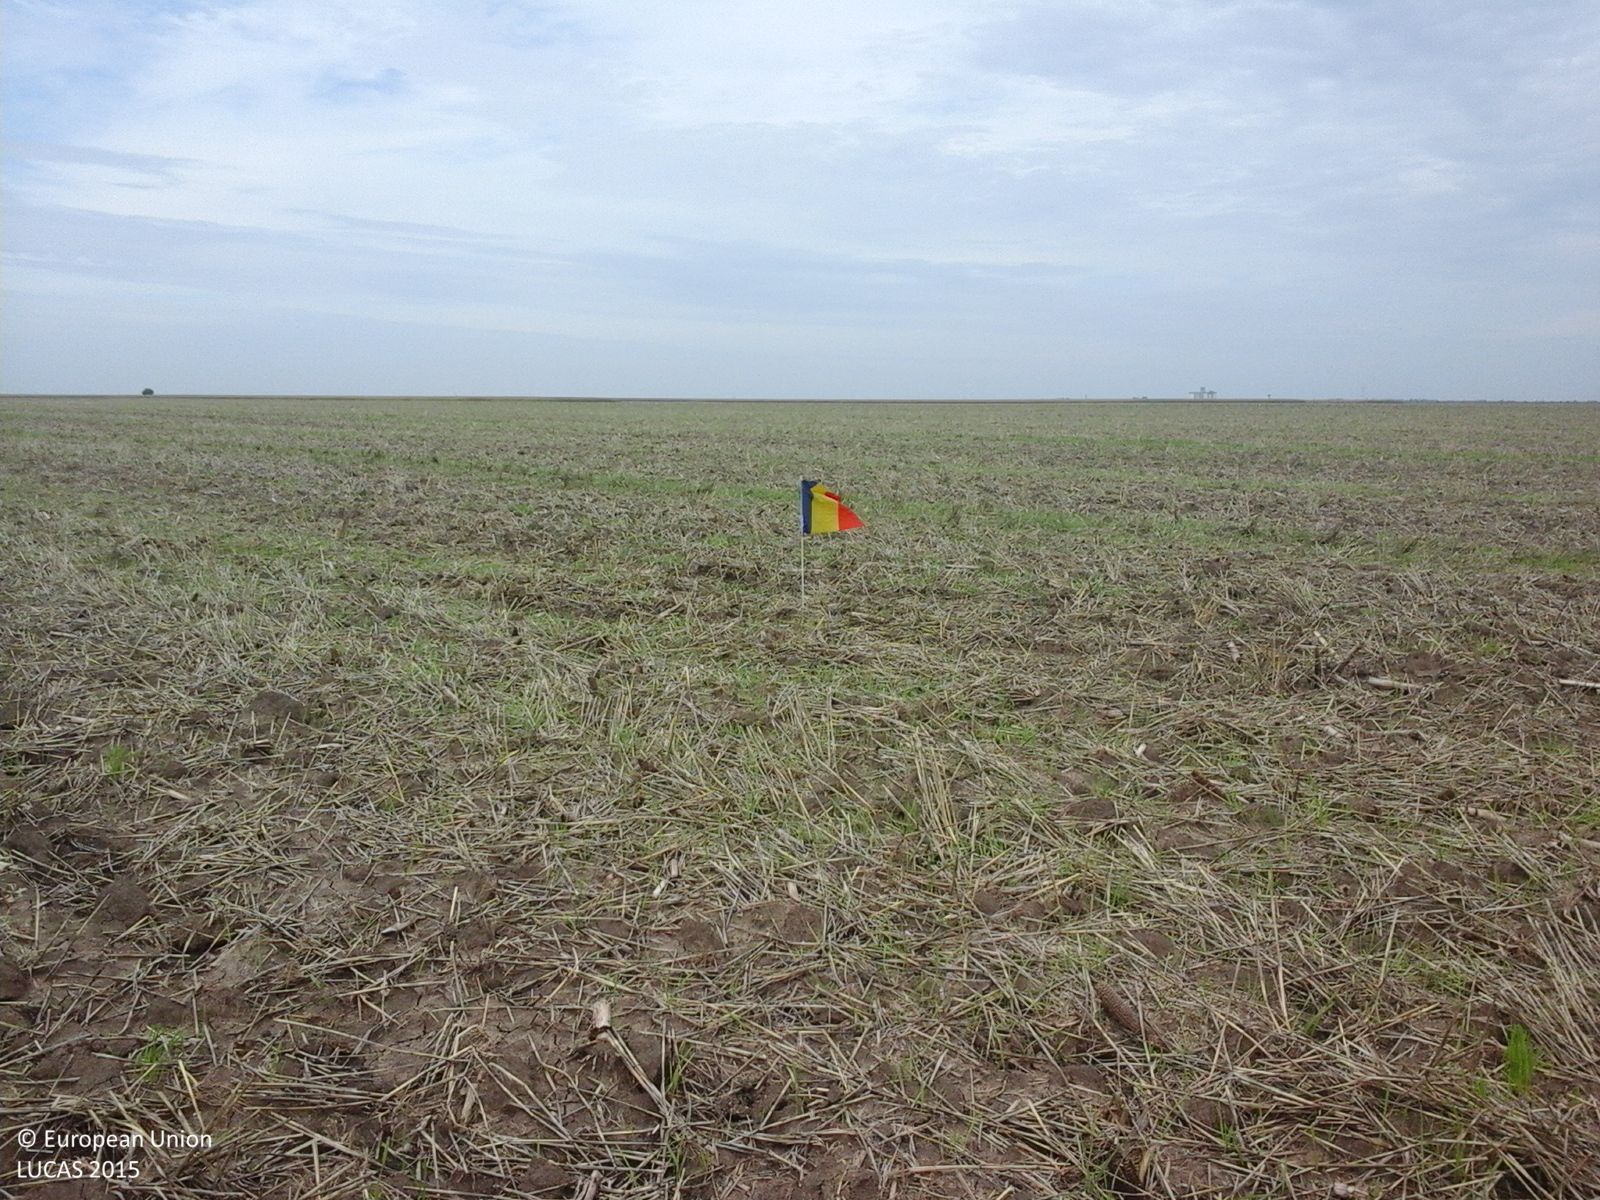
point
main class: Cropland
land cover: Common wheat
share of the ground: 25 - 50 %
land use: Agriculture (excluding fallow land and kitchen gardens)
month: August
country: RO
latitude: 46.2870
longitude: 21.5503
